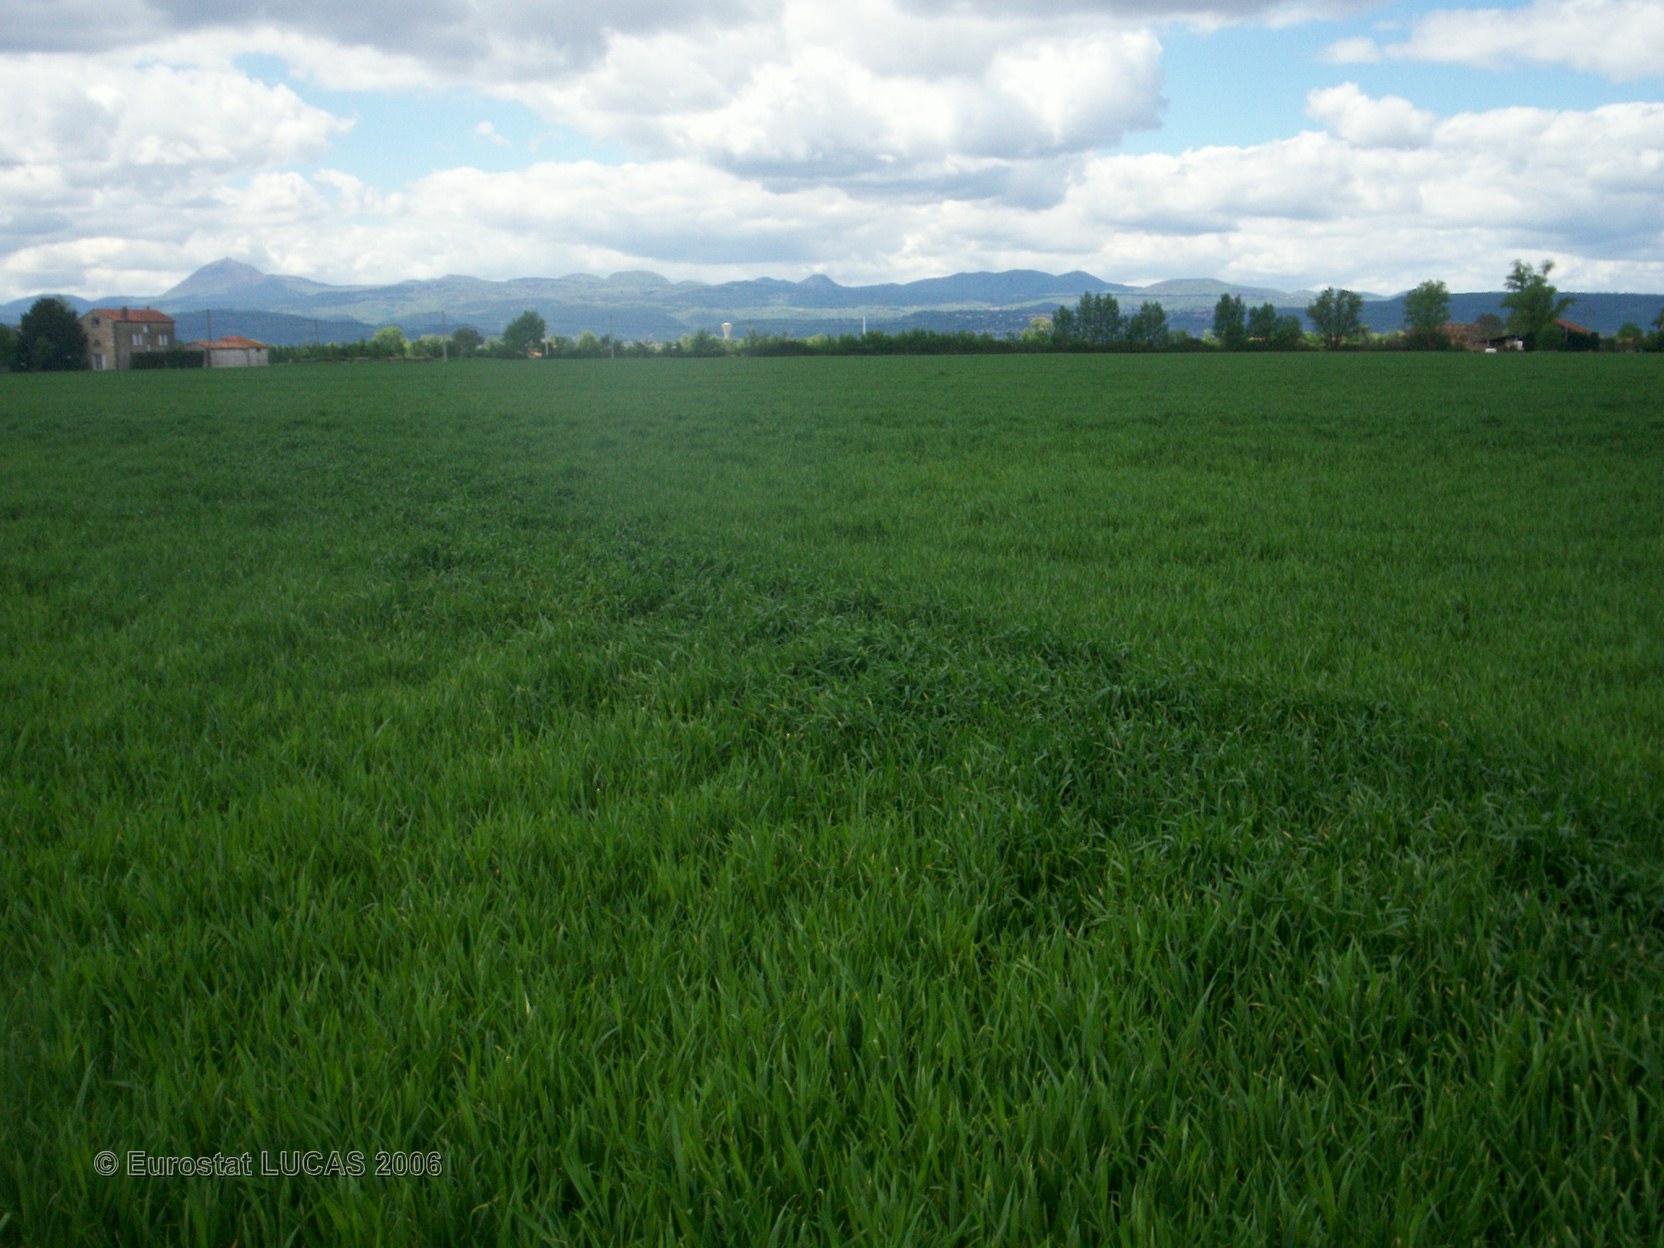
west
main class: Cropland
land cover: Triticale
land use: Agriculture (excluding fallow land and kitchen gardens)
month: May
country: FR
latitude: 45.8448
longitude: 3.1882
